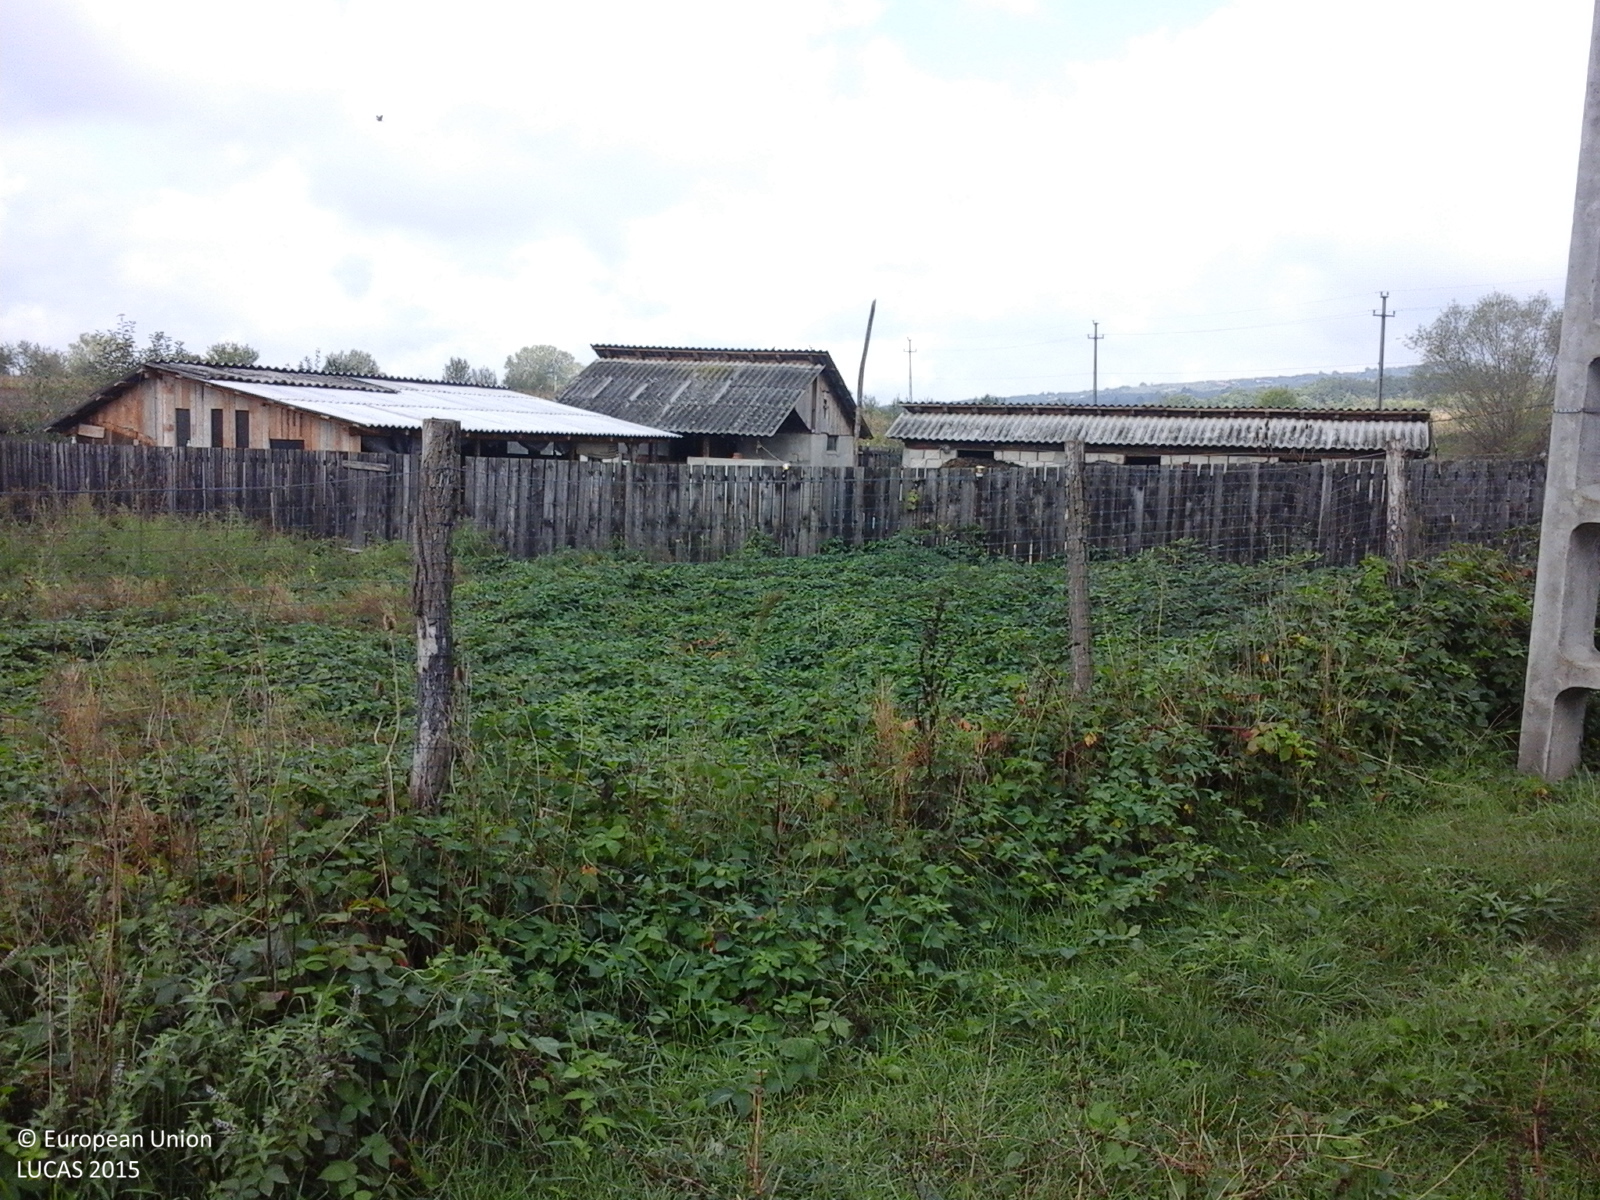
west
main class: Cropland
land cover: Maize
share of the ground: > 75 %
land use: Agriculture (excluding fallow land and kitchen gardens)
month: September
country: RO
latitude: 45.0231
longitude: 23.4455
